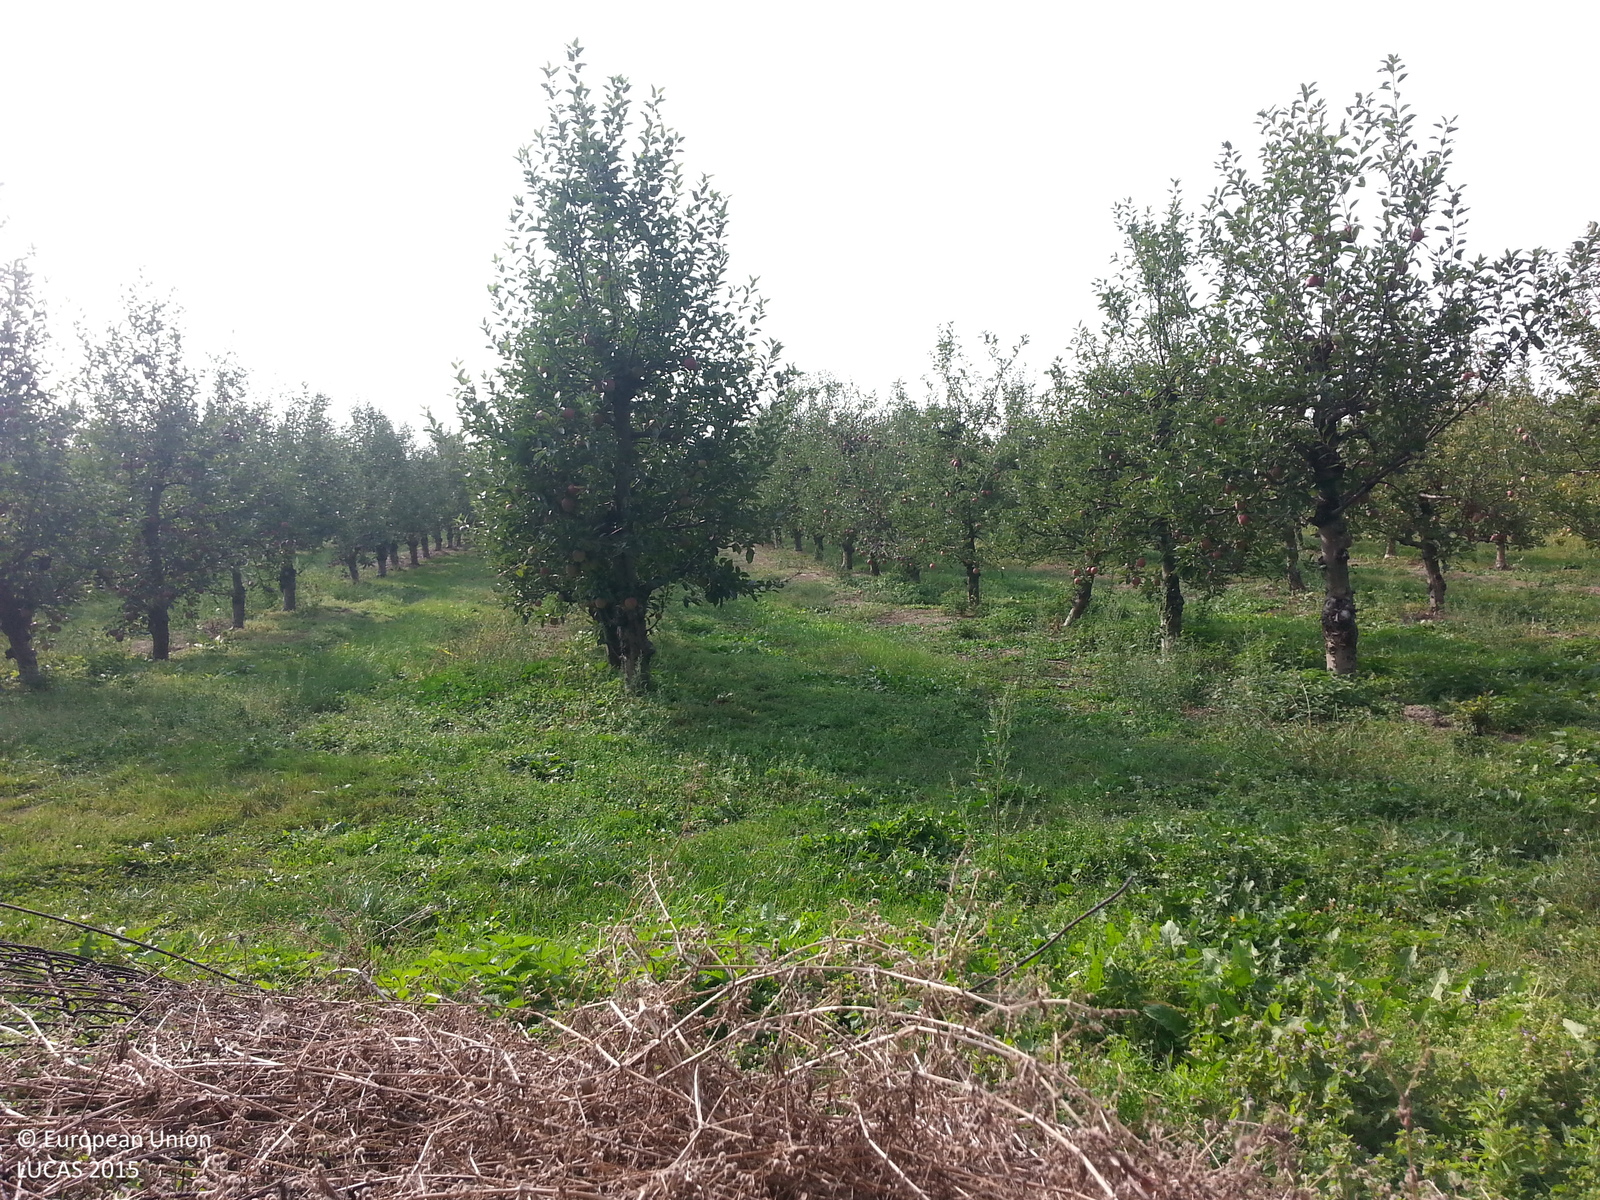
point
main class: Cropland
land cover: Apple fruit
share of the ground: 50 - 75 %
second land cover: Grassland without tree/shrub cover
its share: 50 - 75 %
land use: Agriculture (excluding fallow land and kitchen gardens)
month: September
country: PL
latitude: 52.8963
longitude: 18.0875
